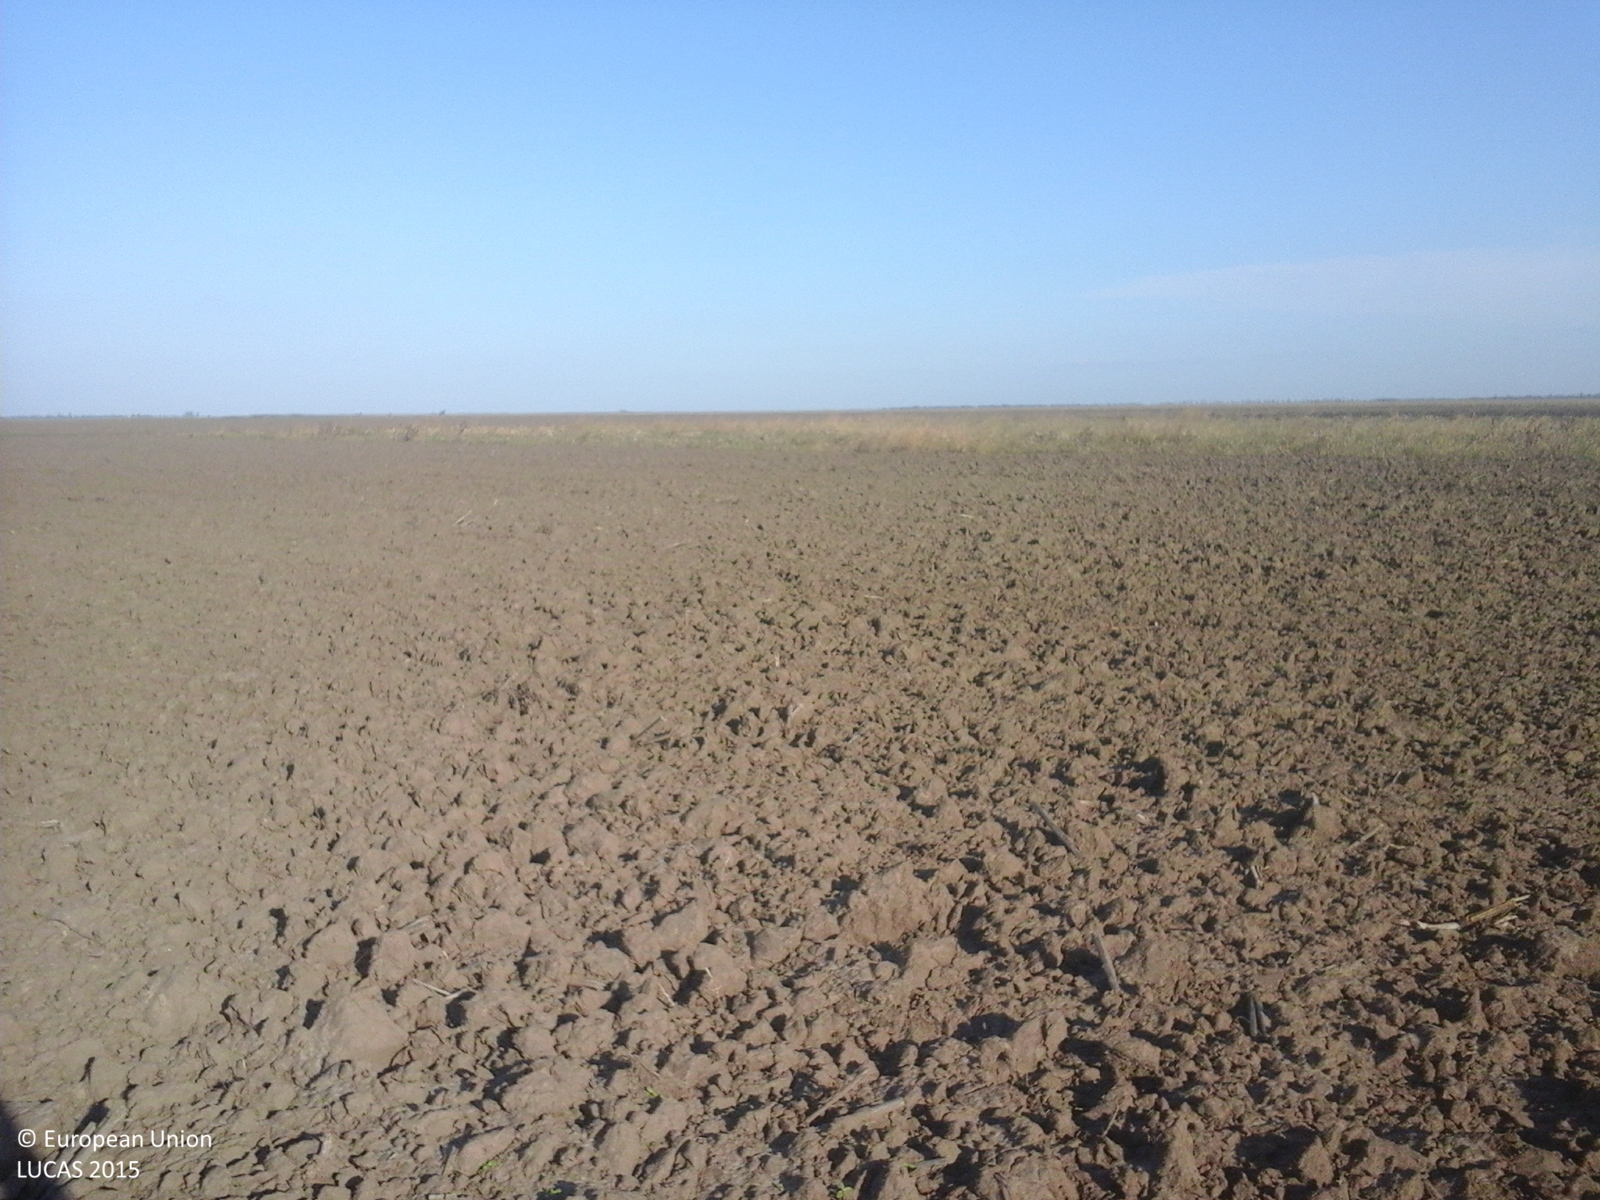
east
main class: Cropland
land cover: Sunflower
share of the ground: < 10 %
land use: Agriculture (excluding fallow land and kitchen gardens)
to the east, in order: Sunflower; Maize; Grass margins; Tracks; Grass margins; Maize
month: October
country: RO
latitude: 45.2572
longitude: 27.3104
